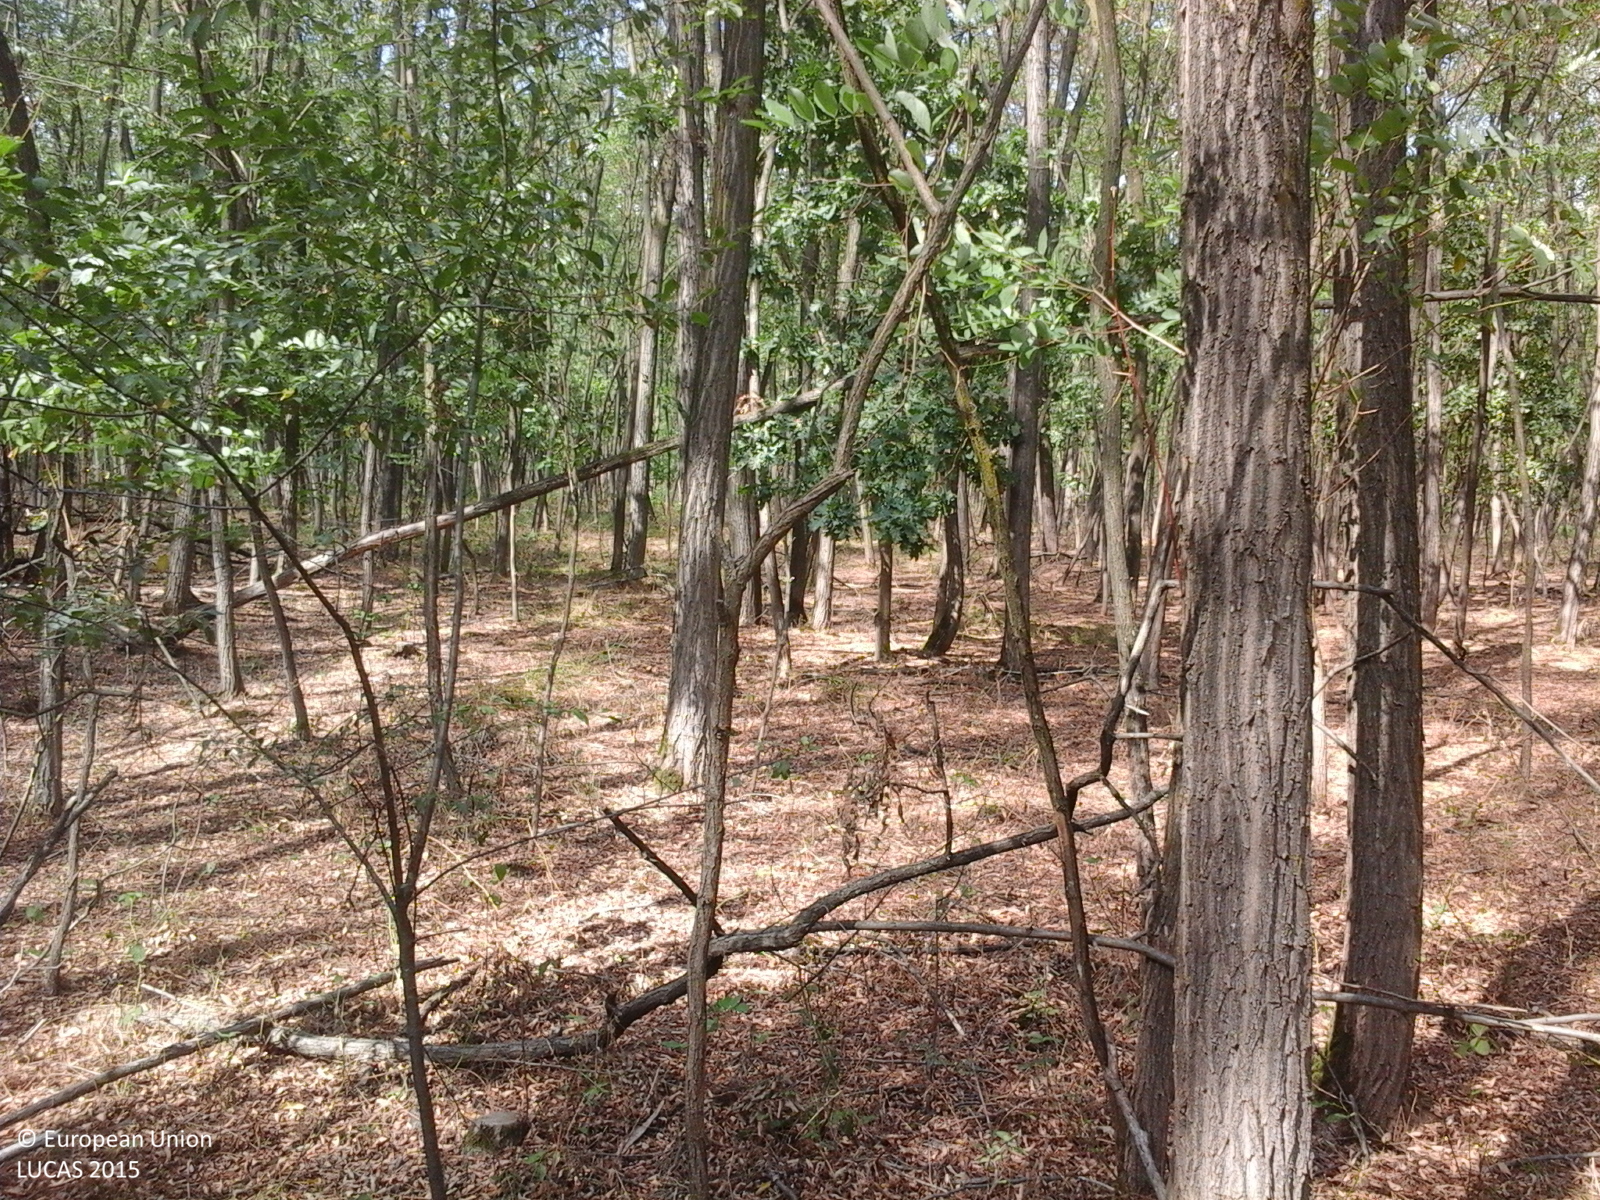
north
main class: Woodland
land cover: Broadleaved woodland
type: exotic forest
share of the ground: > 75 %
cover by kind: broadleaved forest trees 100 %
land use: Forestry
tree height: > 5 m
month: September
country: RO
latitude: 47.6397
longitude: 22.9360
